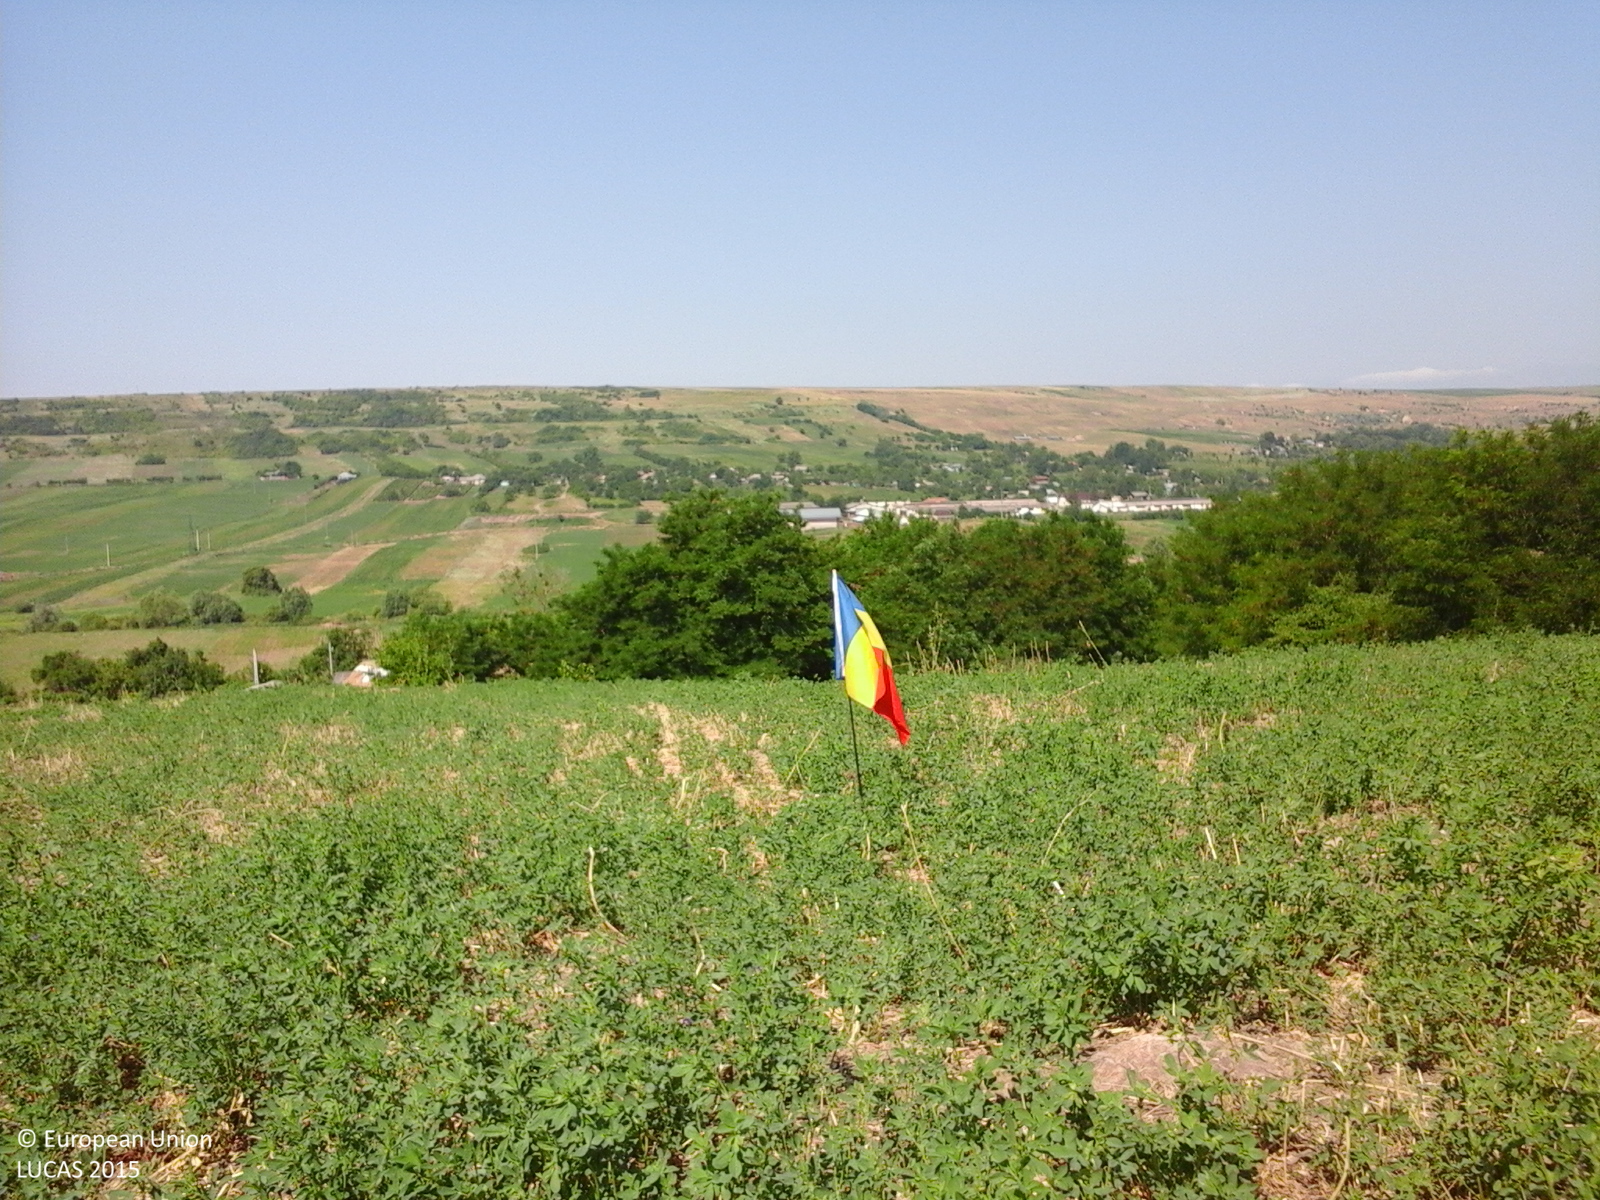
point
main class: Cropland
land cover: Lucerne
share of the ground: < 10 %
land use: Agriculture (excluding fallow land and kitchen gardens)
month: June
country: RO
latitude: 46.9792
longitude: 27.8055
